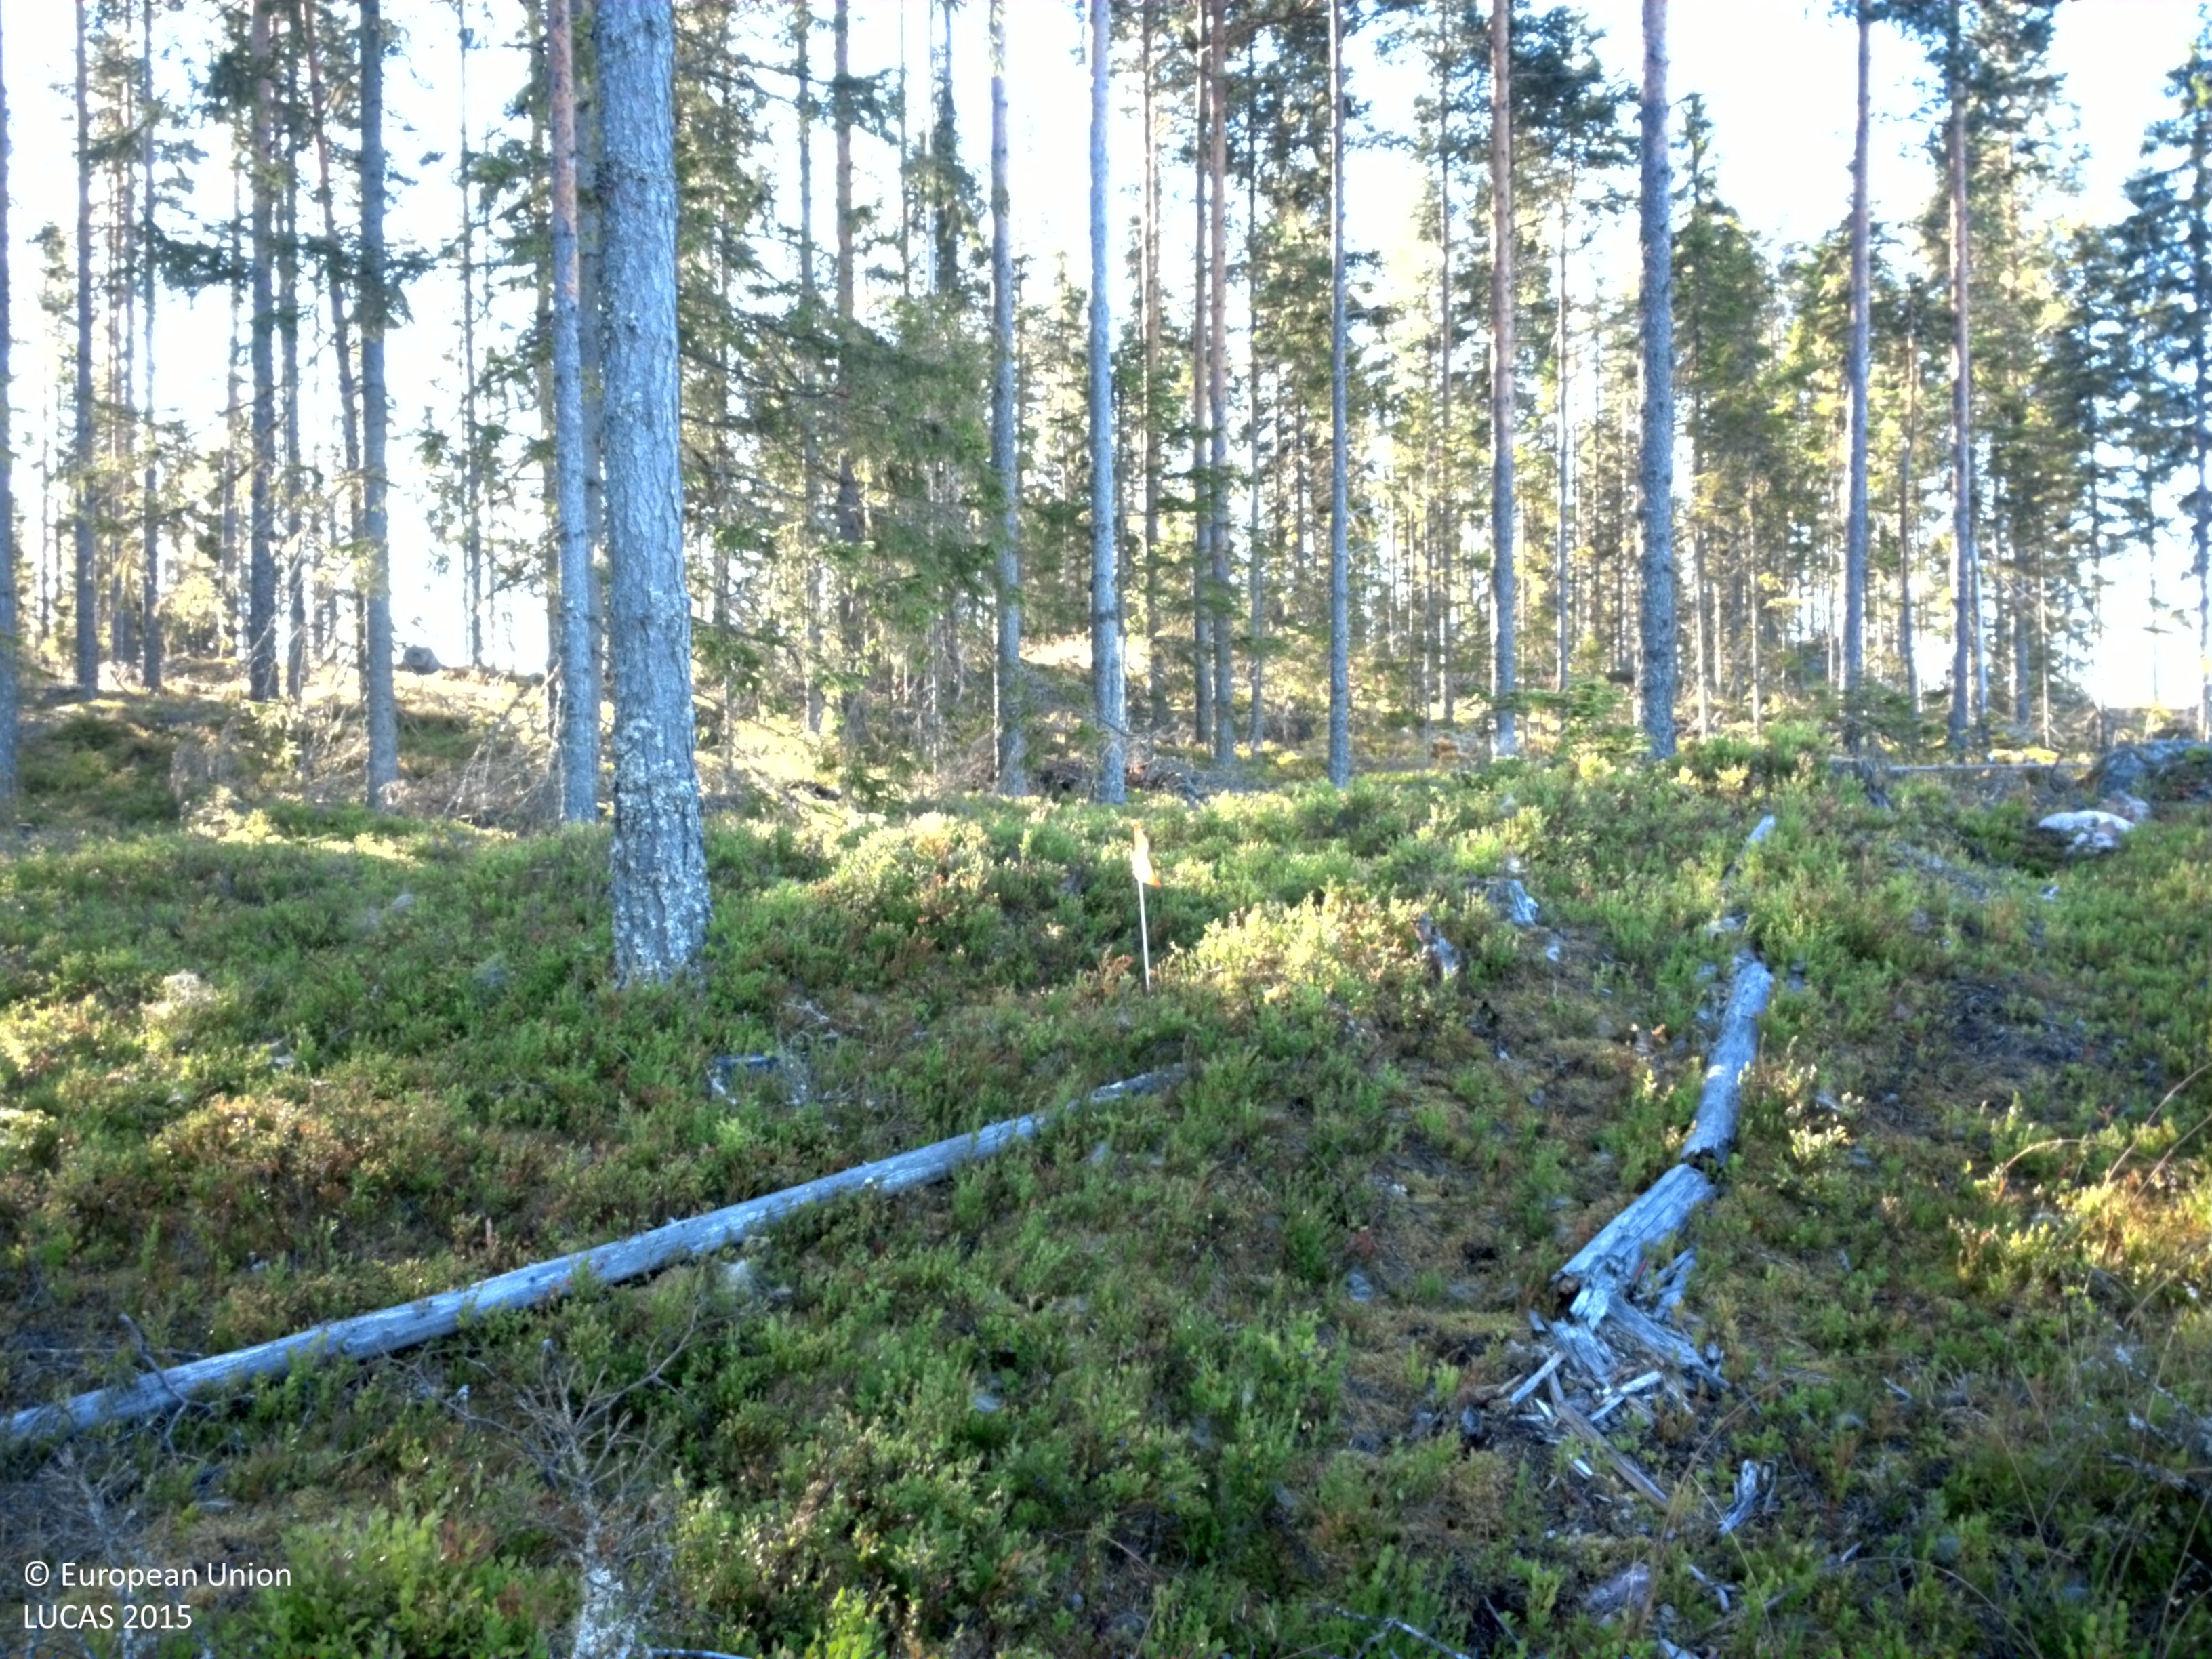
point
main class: Woodland
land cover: Other coniferous woodland
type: boreal forest
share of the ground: 50 - 75 %
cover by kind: coniferous forest trees 70 %, shrubs 30 %
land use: Forestry
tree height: > 5 m
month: August
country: SE
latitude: 60.0109
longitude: 14.1690
